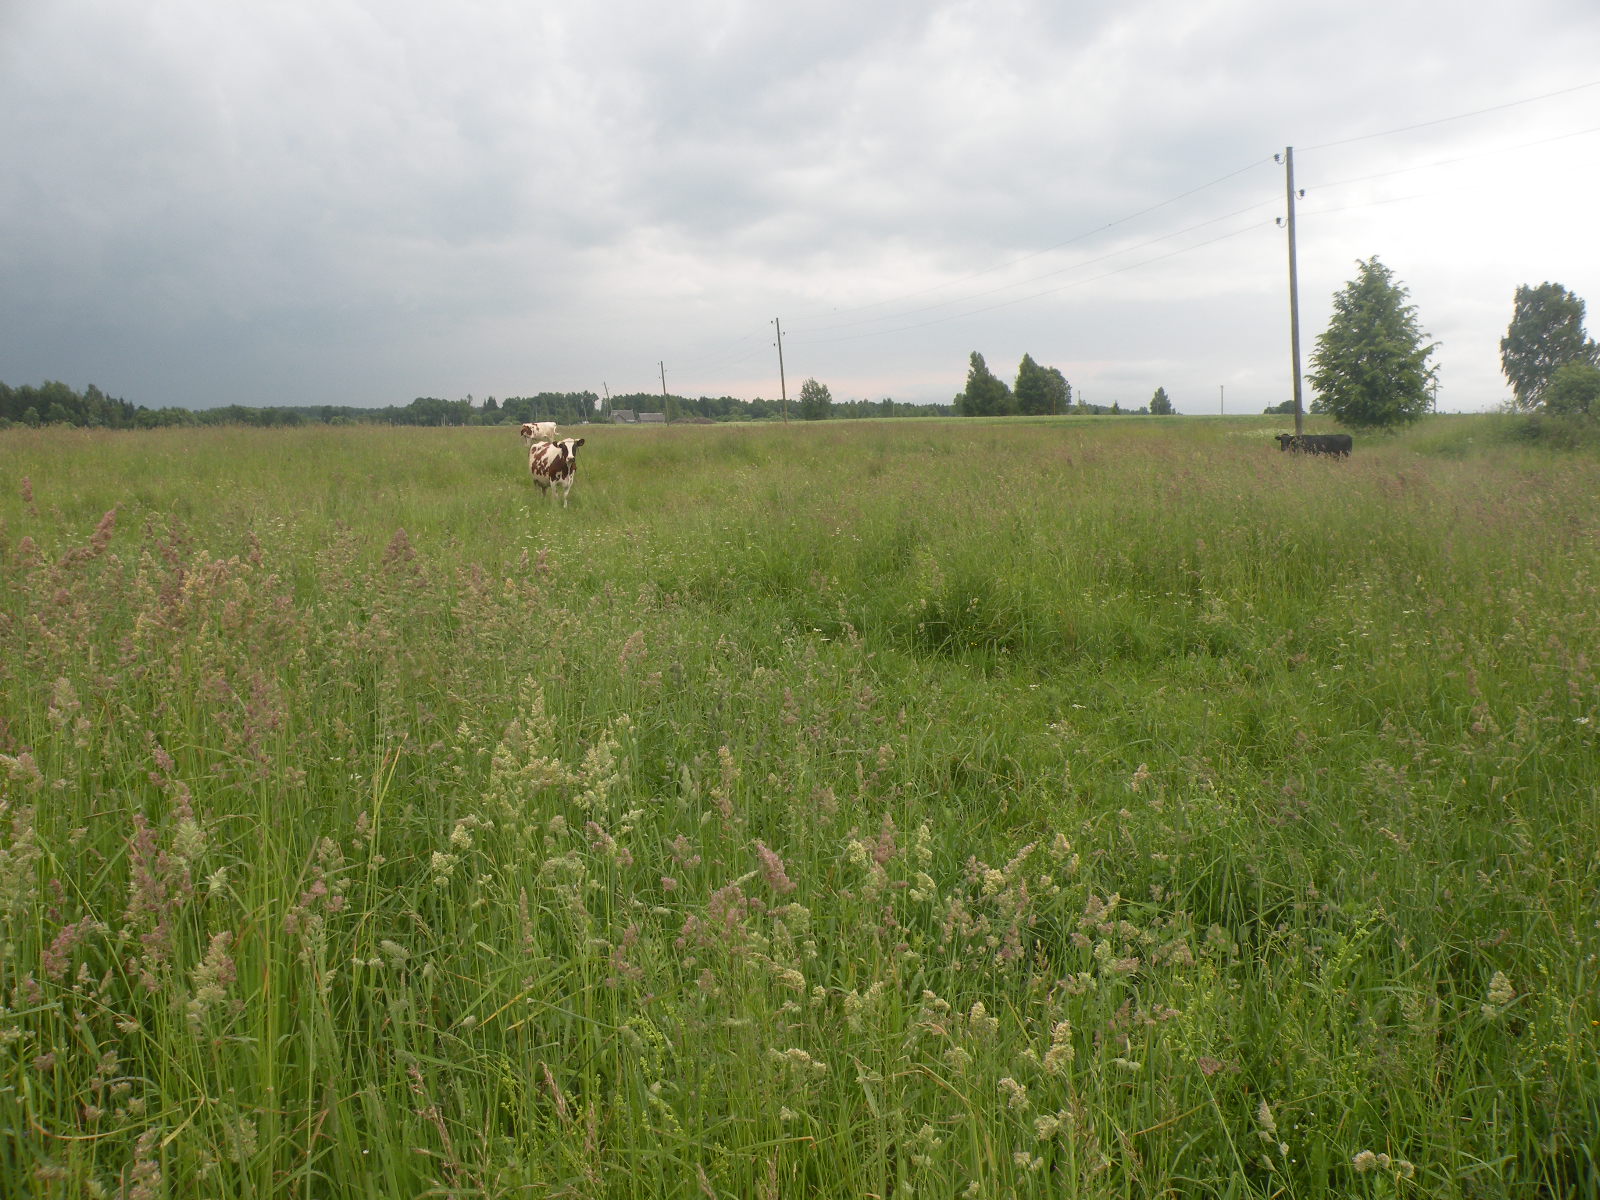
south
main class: Grassland
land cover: Grassland without tree/shrub cover
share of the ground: > 75 %
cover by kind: herbaceous plants 100 %
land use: Agriculture (excluding fallow land and kitchen gardens)
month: June
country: LV
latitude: 56.0425
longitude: 26.6730
